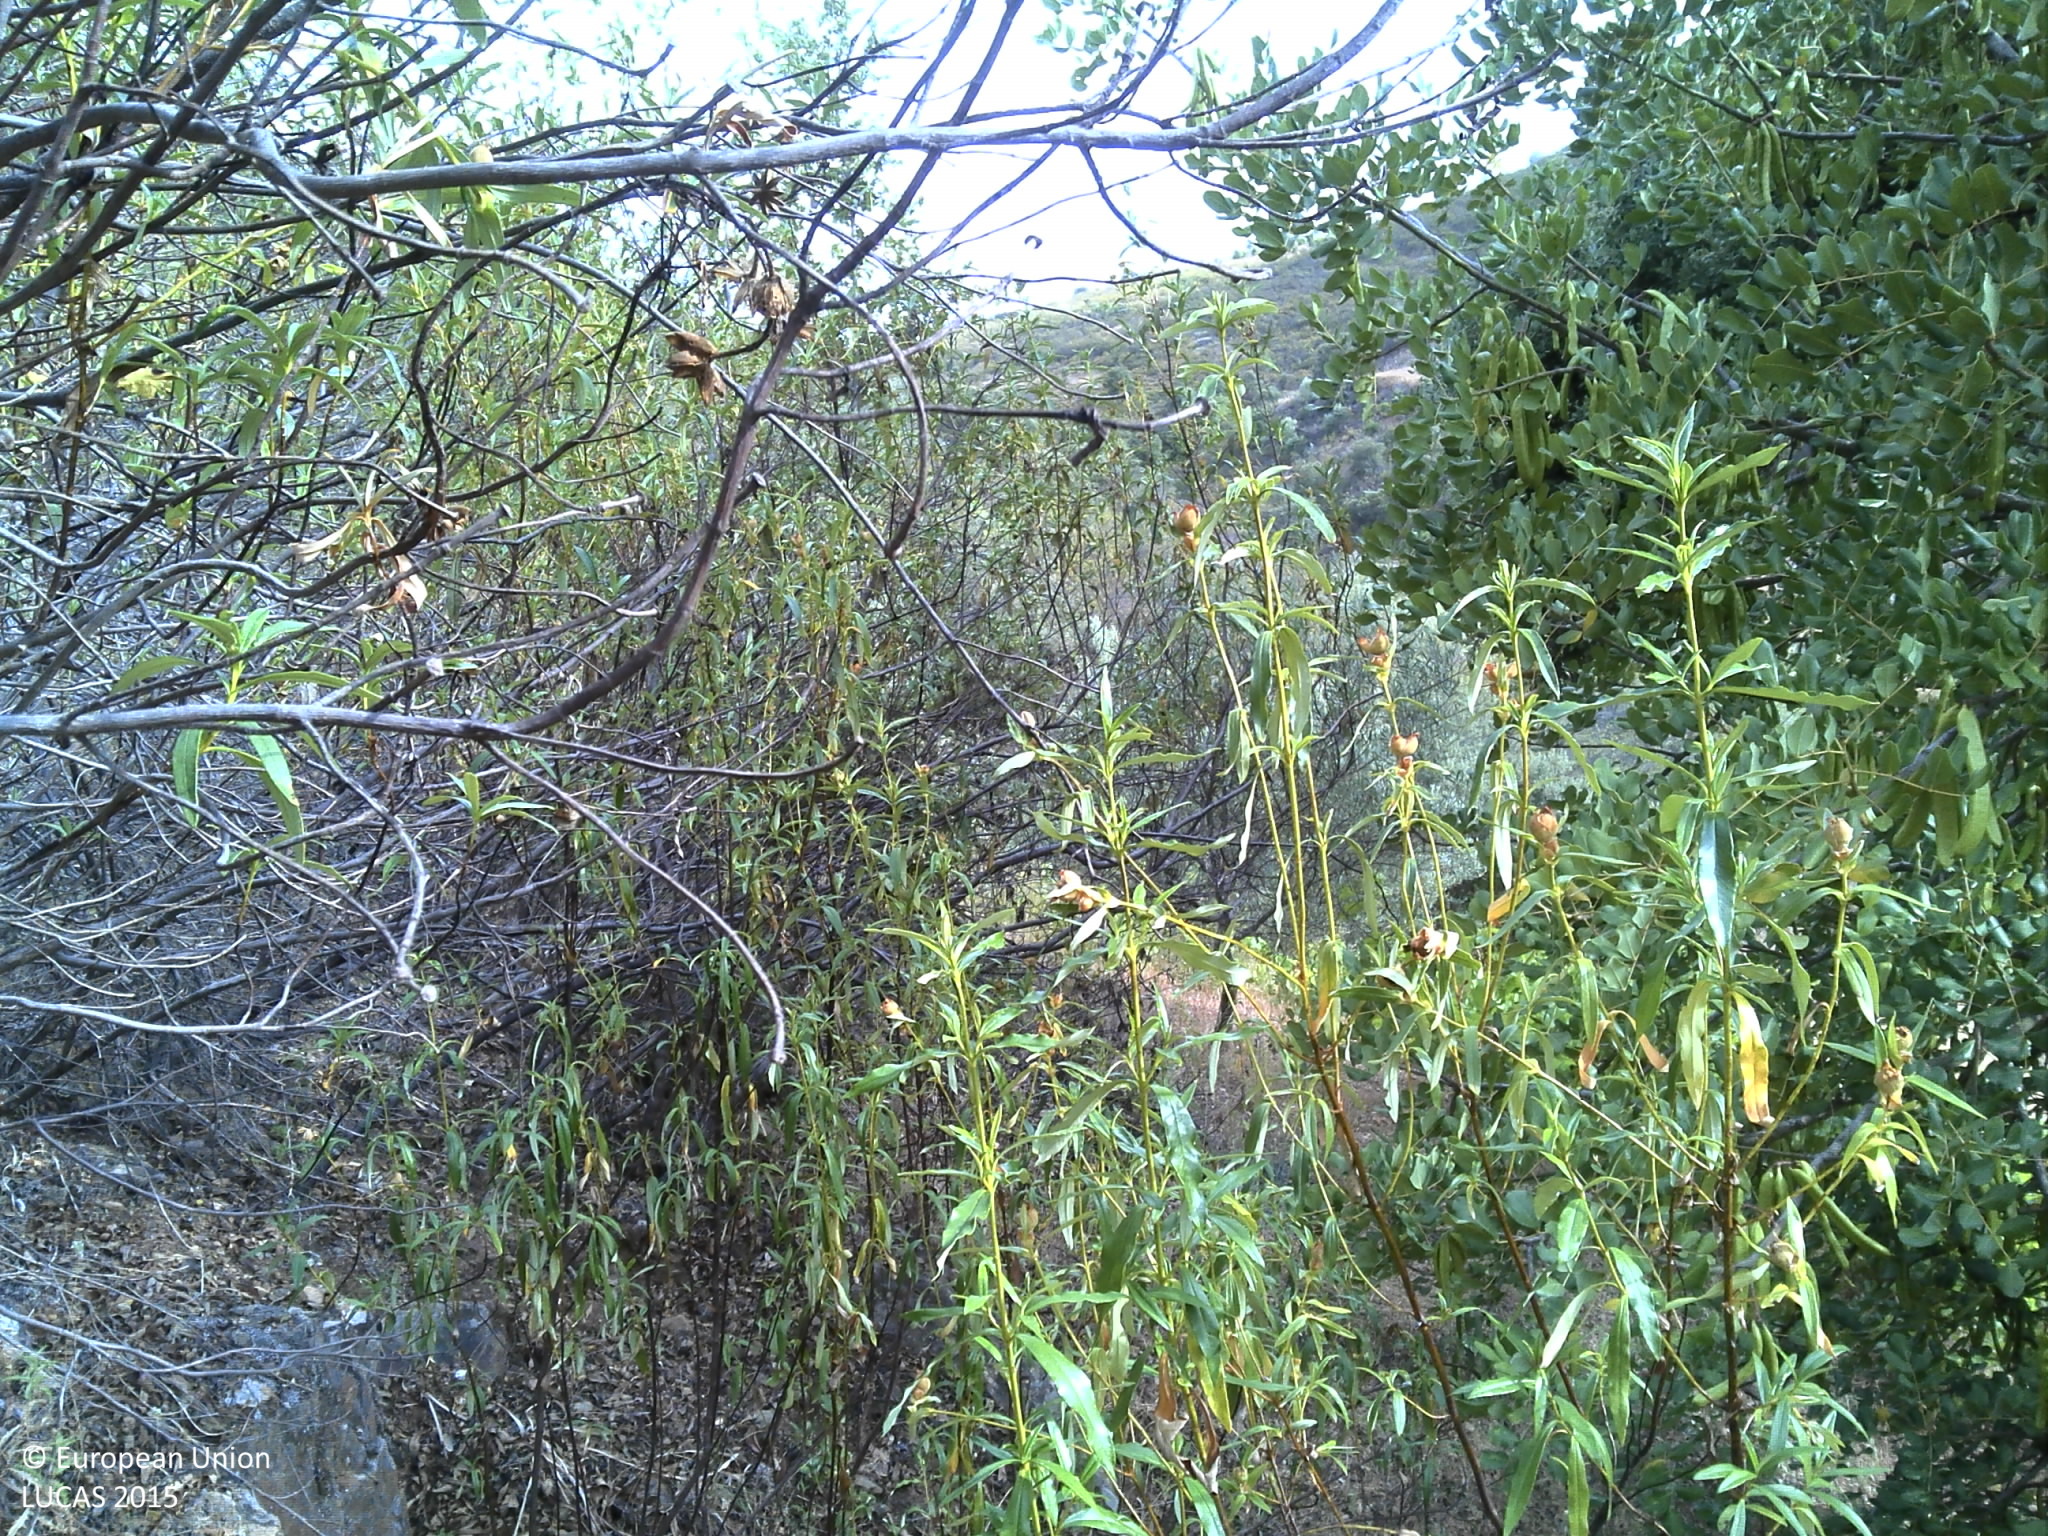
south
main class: Shrubland
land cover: Shrubland without tree cover
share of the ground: > 75 %
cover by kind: shrubs 100 %
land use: Abandoned areas
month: June
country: PT
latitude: 37.2749
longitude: -7.7038
